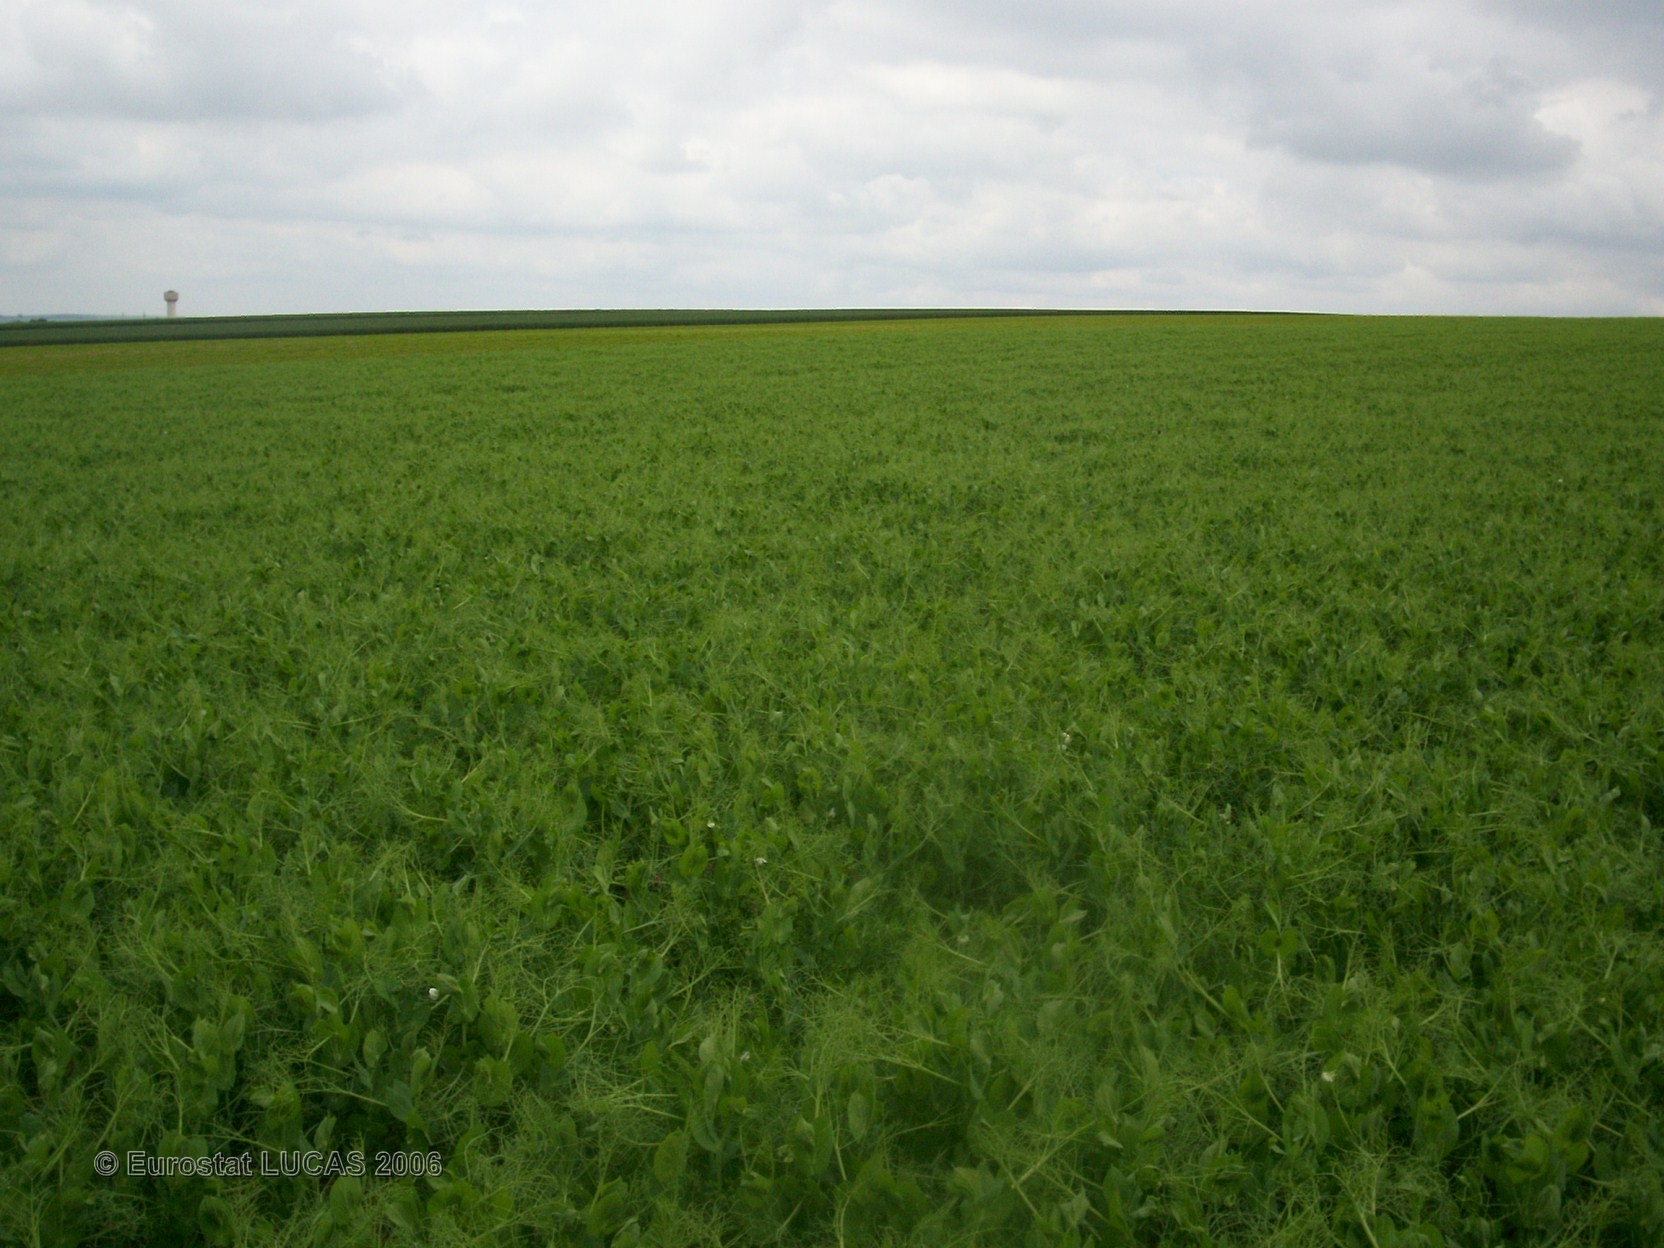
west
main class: Cropland
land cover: Common wheat
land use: Agriculture (excluding fallow land and kitchen gardens)
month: June
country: FR
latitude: 48.5875
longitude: 4.4250
